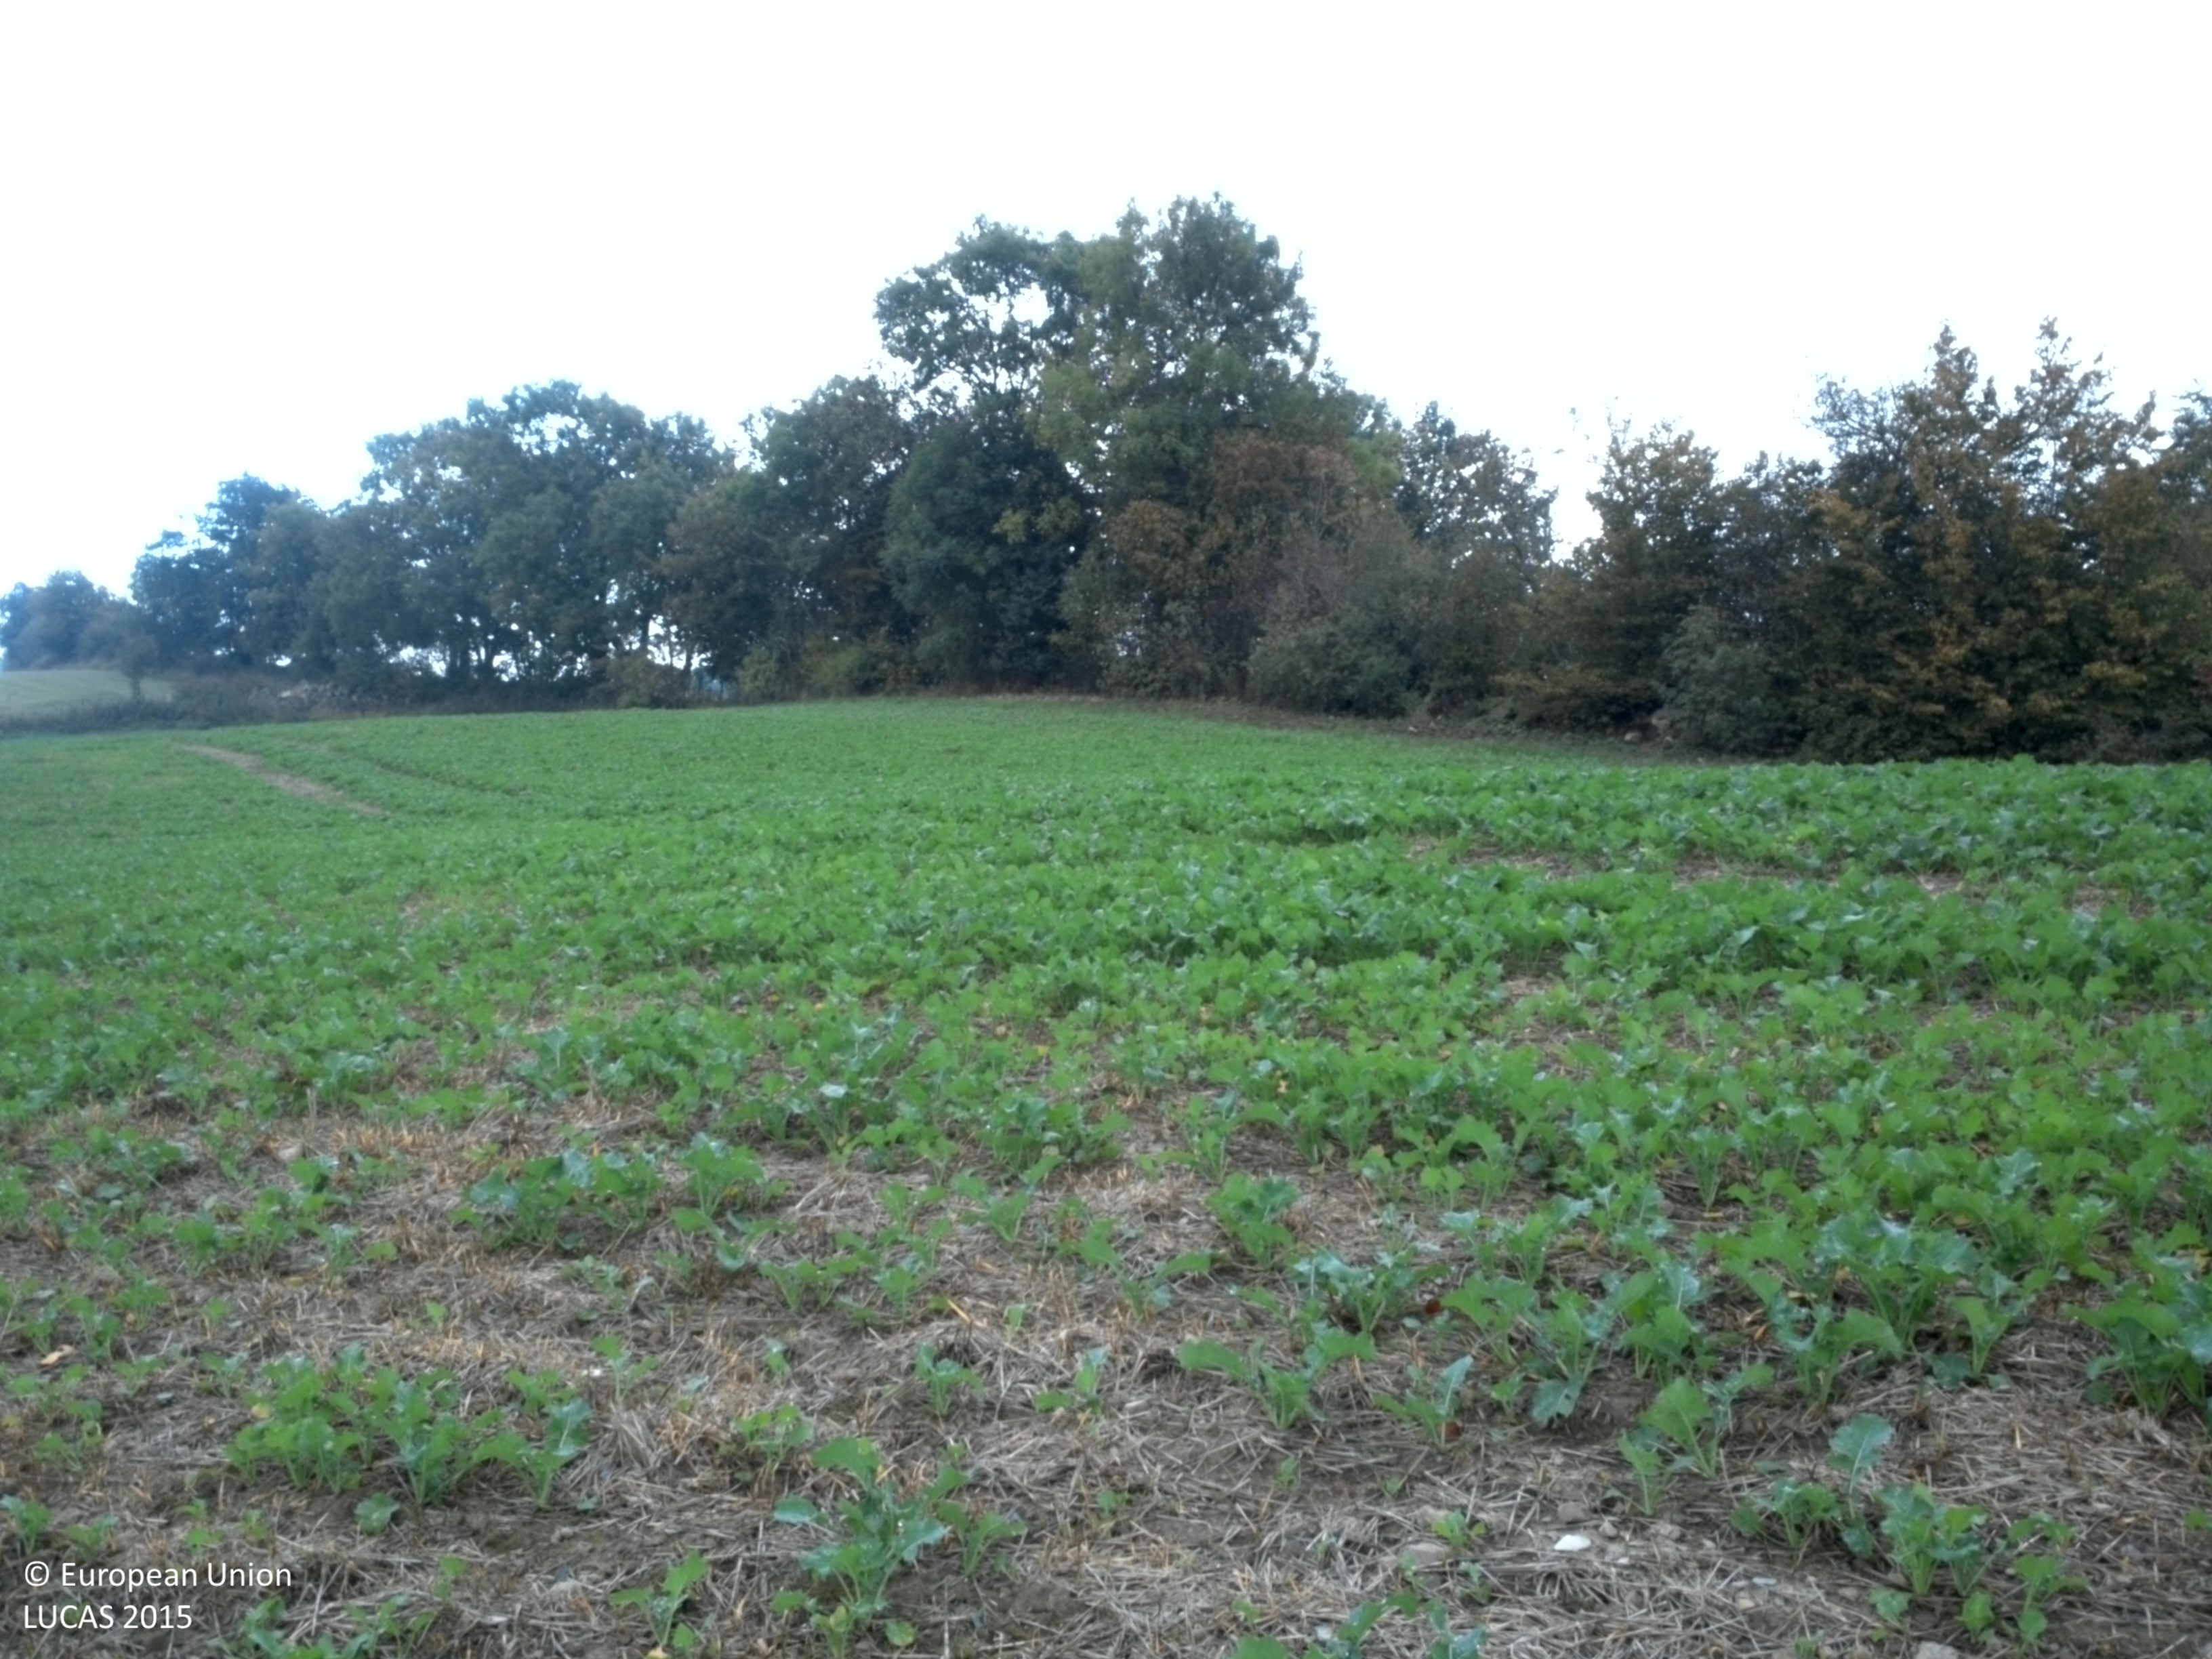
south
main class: Cropland
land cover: Rape and turnip rape
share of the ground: 50 - 75 %
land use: Agriculture (excluding fallow land and kitchen gardens)
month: October
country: SE
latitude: 55.6399
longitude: 13.9860
